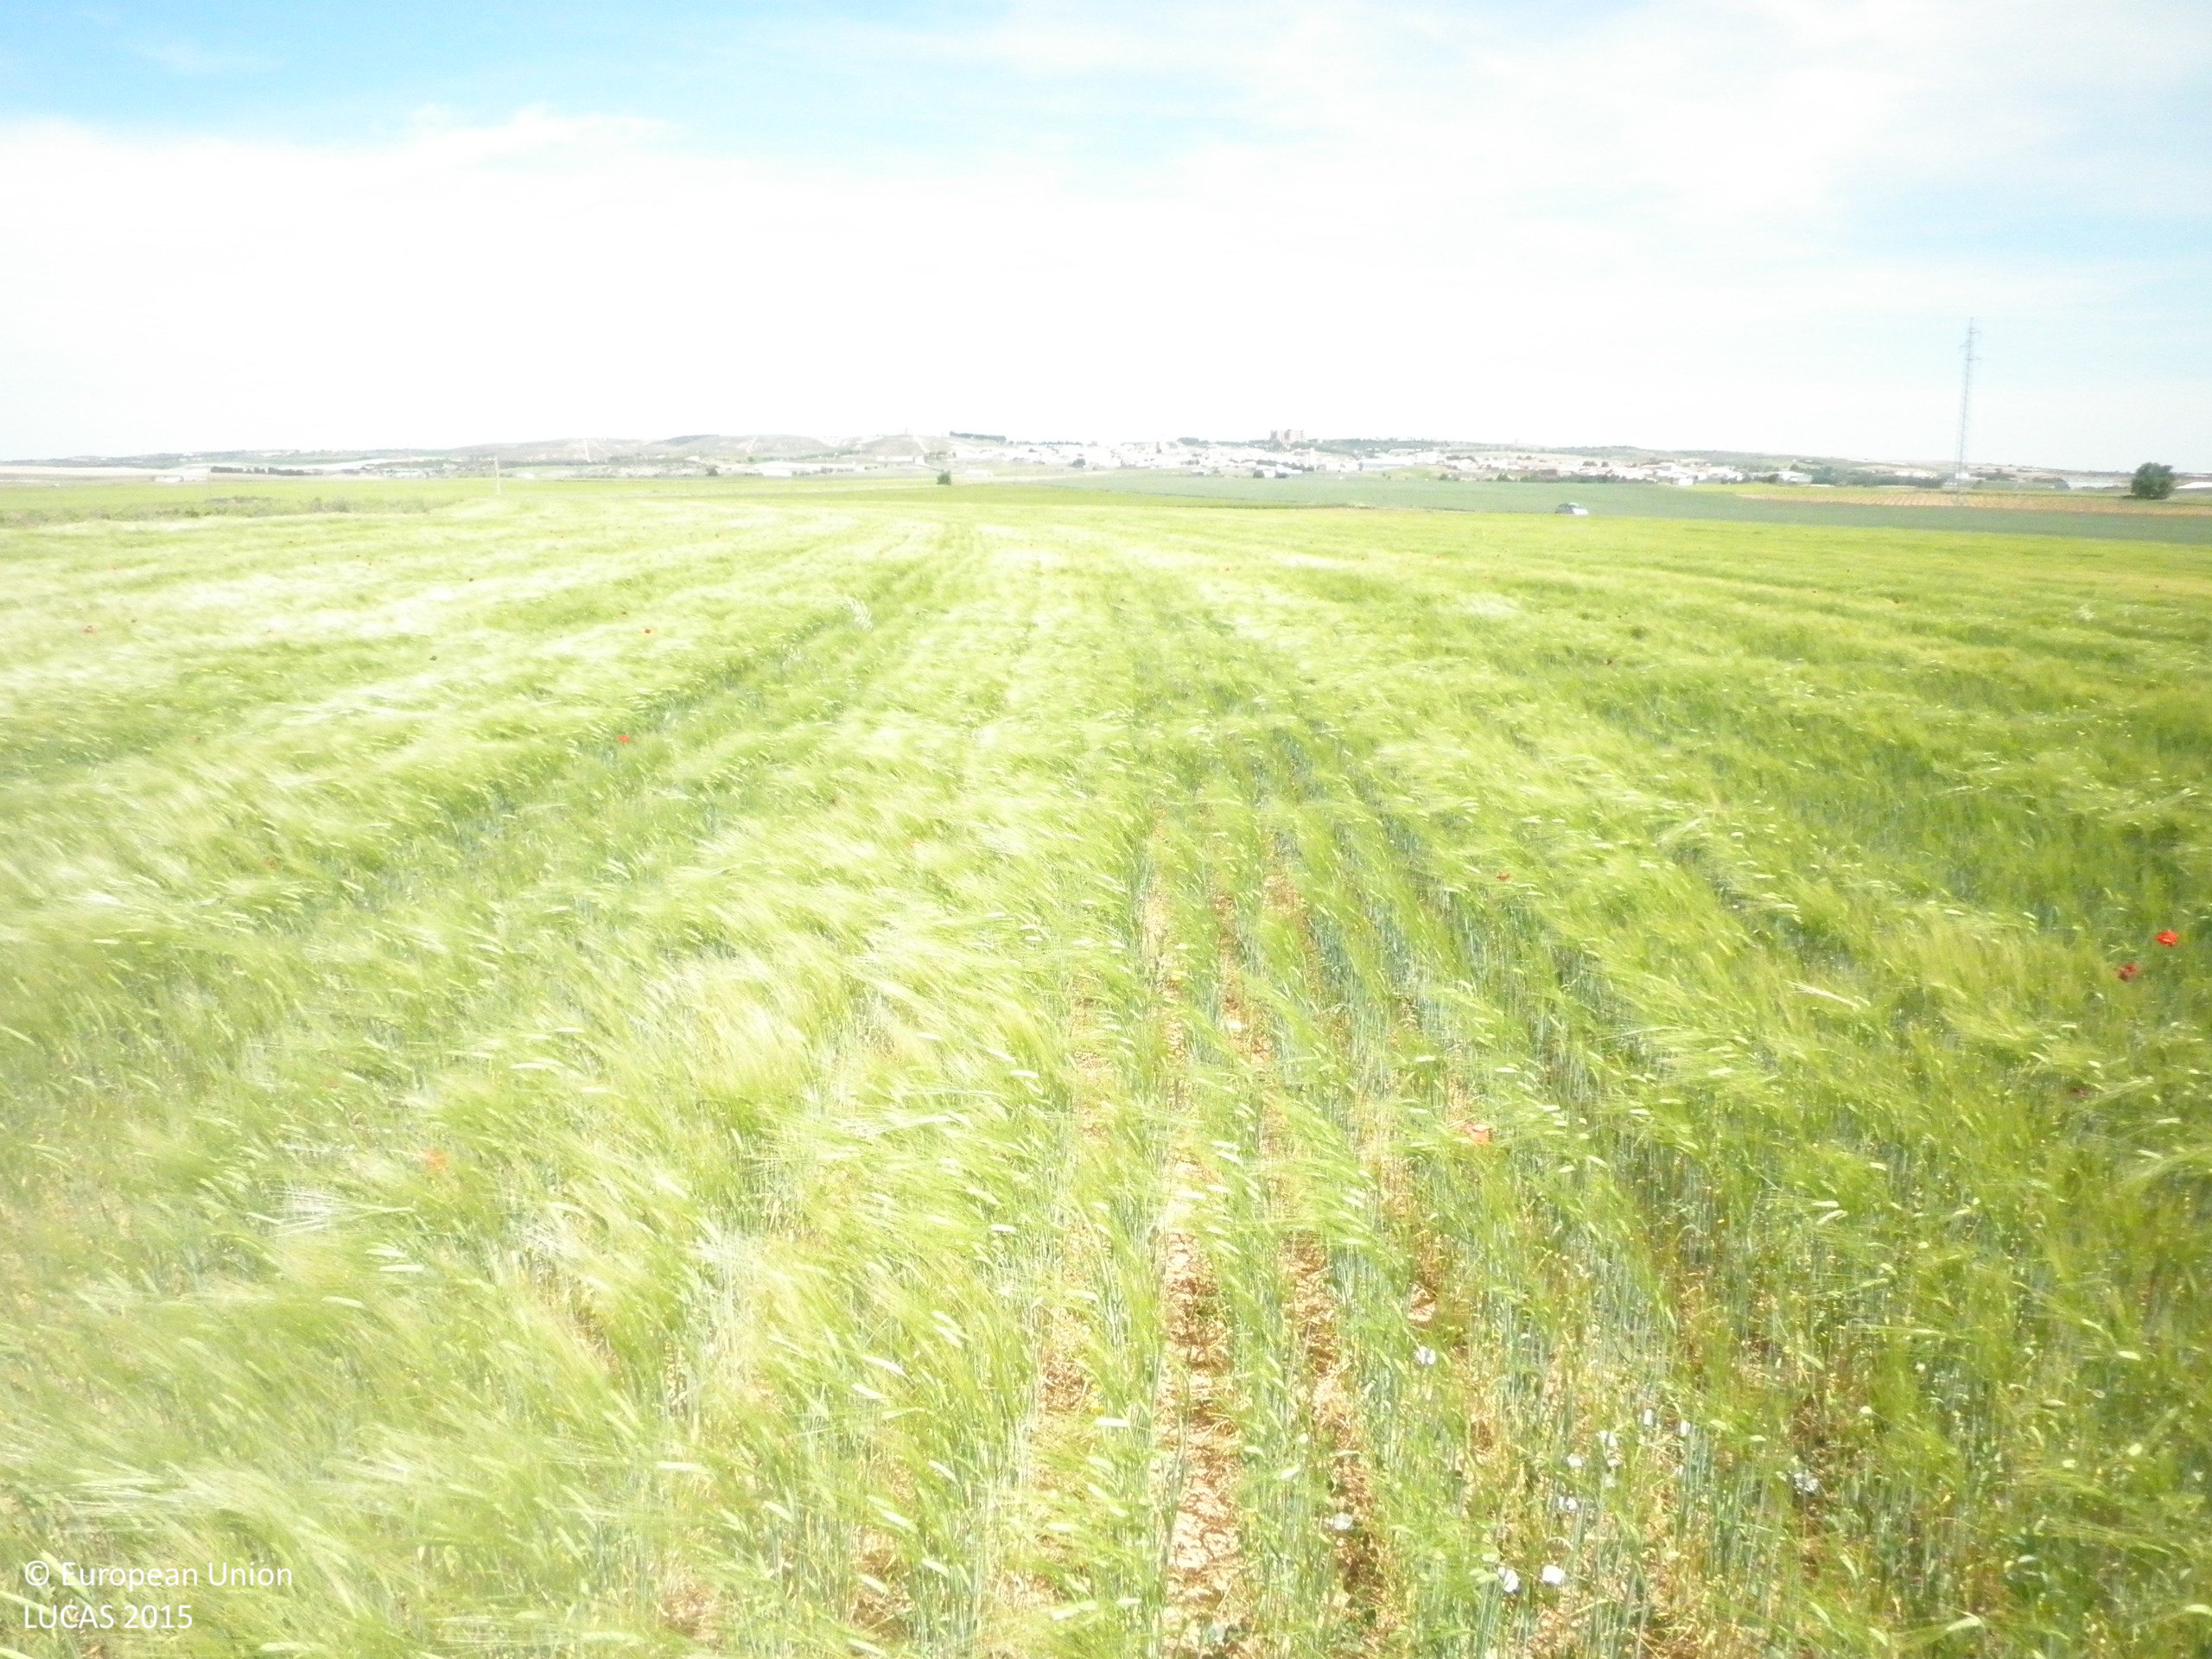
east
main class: Cropland
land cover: Barley
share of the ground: > 75 %
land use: Agriculture (excluding fallow land and kitchen gardens)
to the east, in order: Barley; Other bare soil; Barley
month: May
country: ES
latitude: 39.5616
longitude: -2.7368
